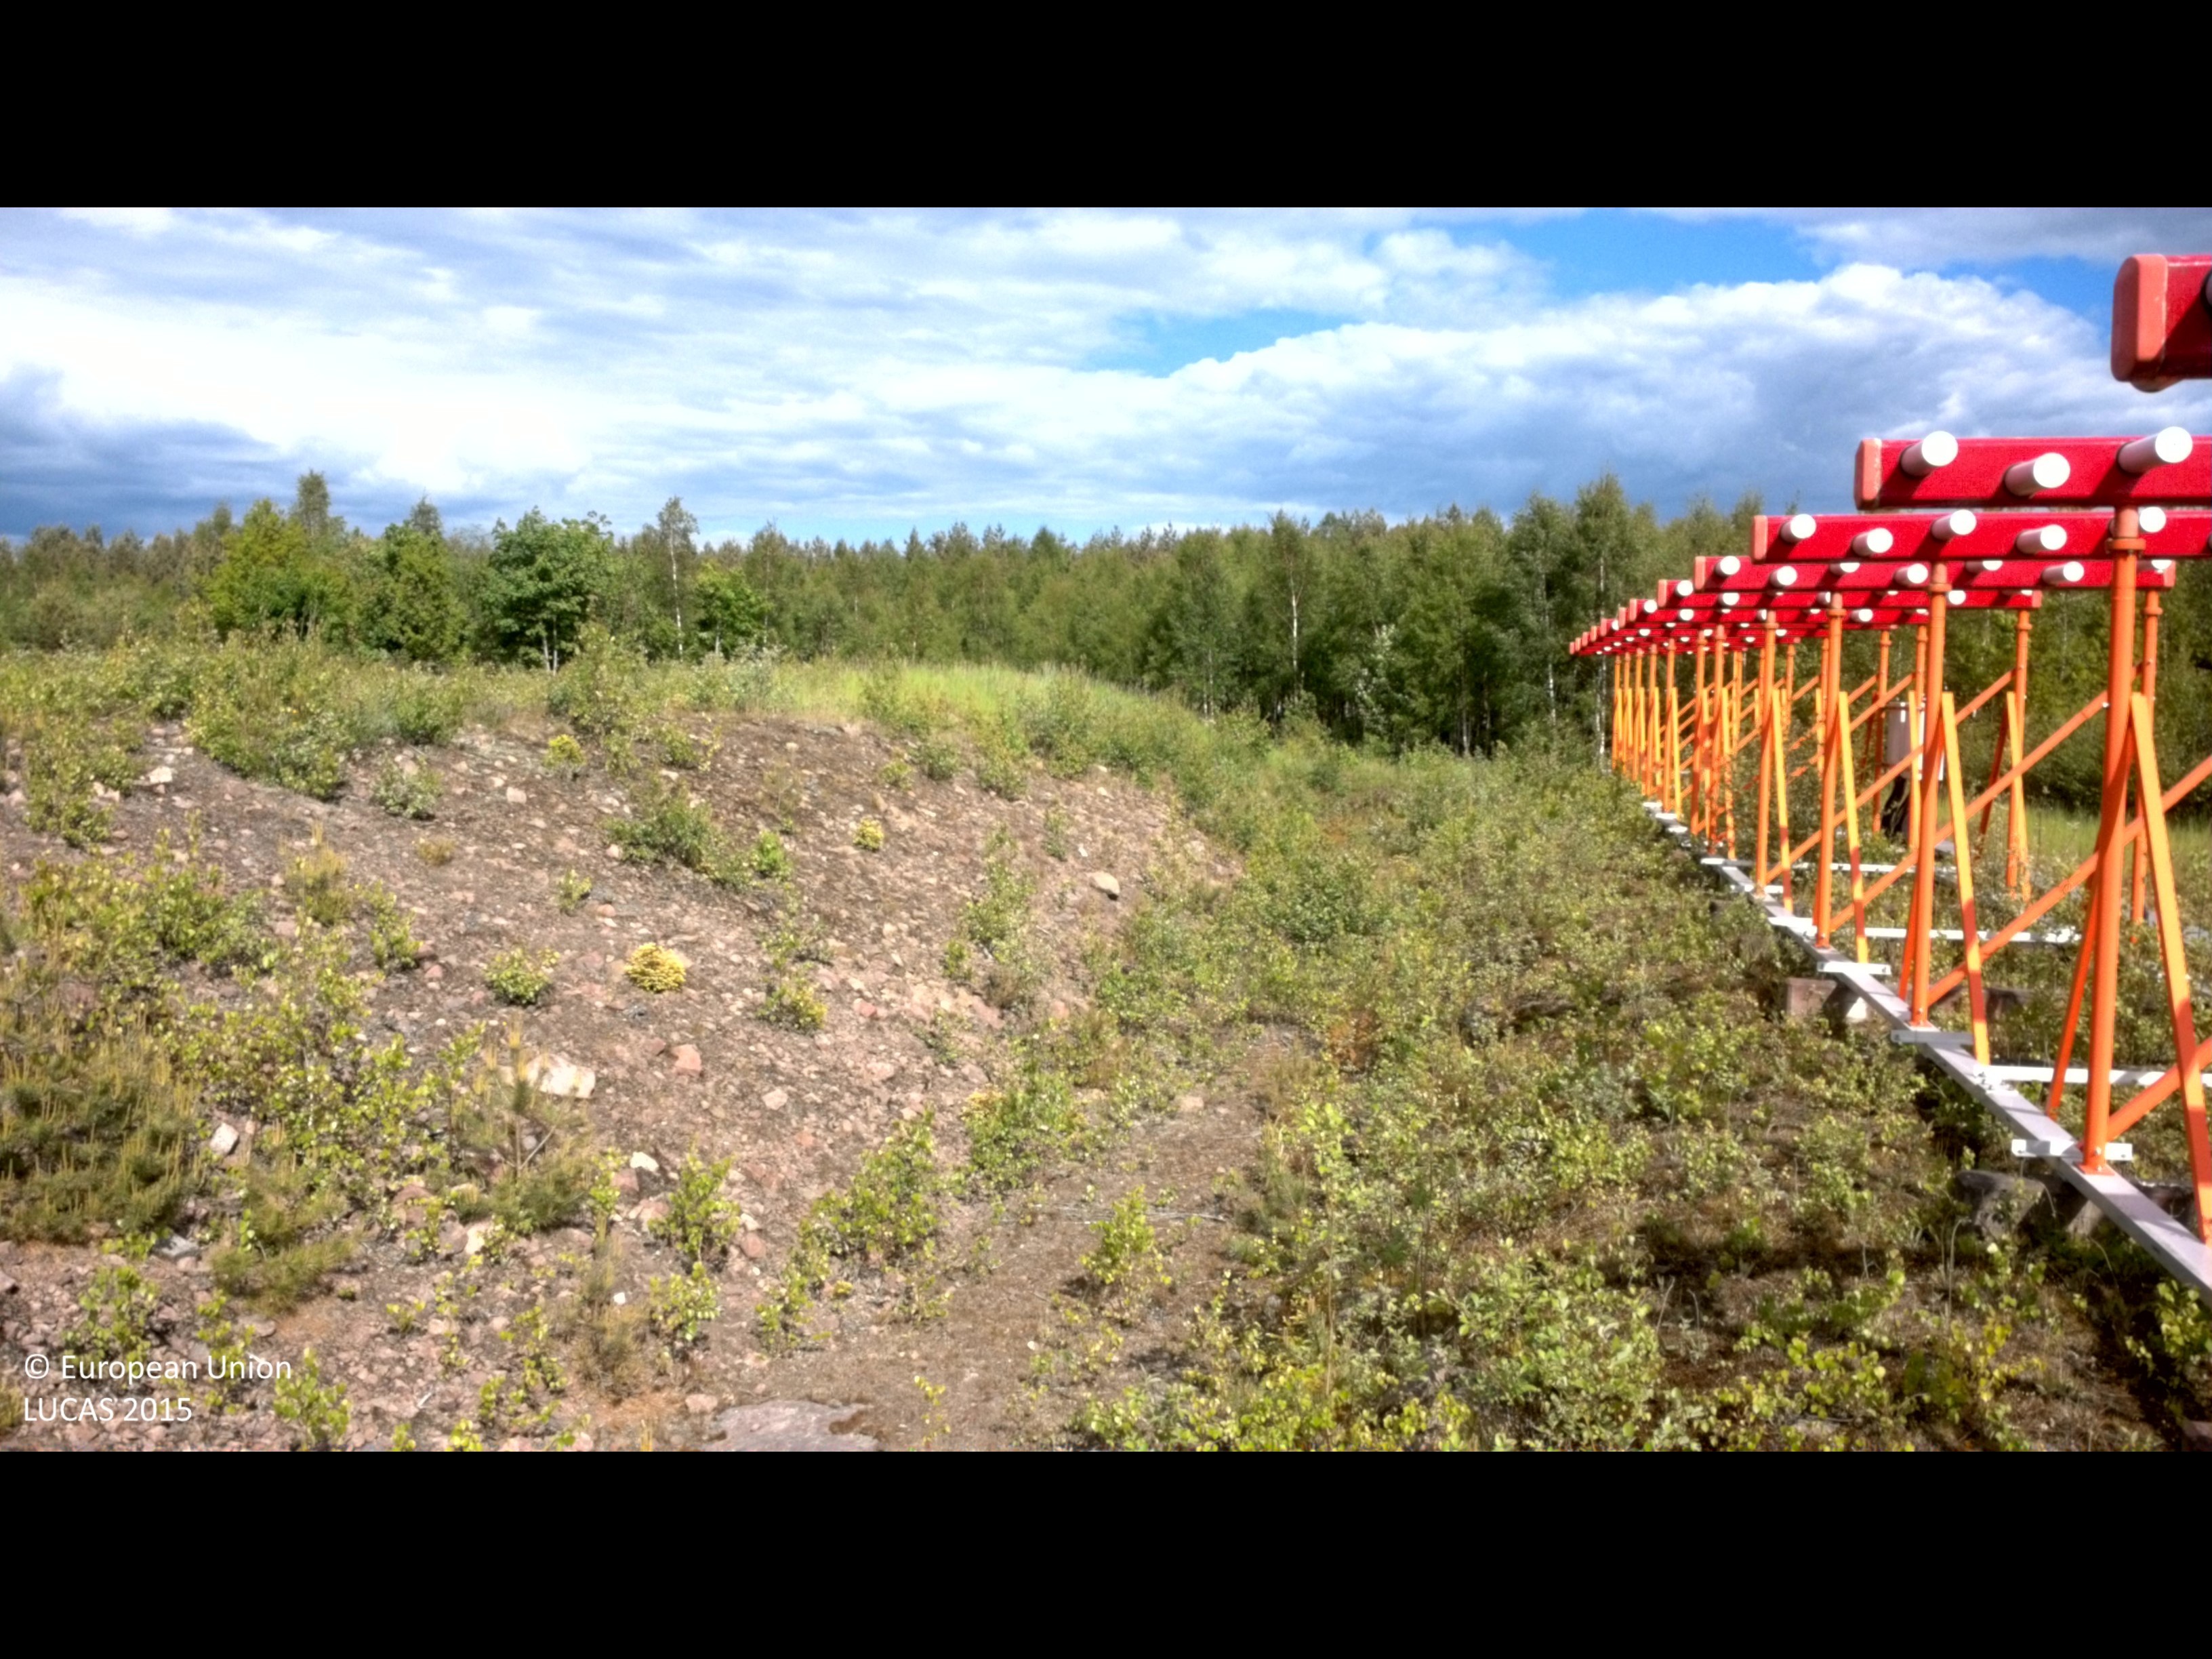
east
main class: Shrubland
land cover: Shrubland with sparse tree cover
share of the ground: > 75 %
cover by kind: shrubs 45 %, unconsolidated bare surface 30 %, herbaceous plants 10 %, broadleaved forest trees 5 %
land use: Air transport
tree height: < 5 m
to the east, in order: Shrubland with sparse tree cover; Tracks; Broadleaved woodland; Paved roads, cycling and walking lanes; Pine dominated coniferous woodland
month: May
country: SE
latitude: 57.3405
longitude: 16.4960
